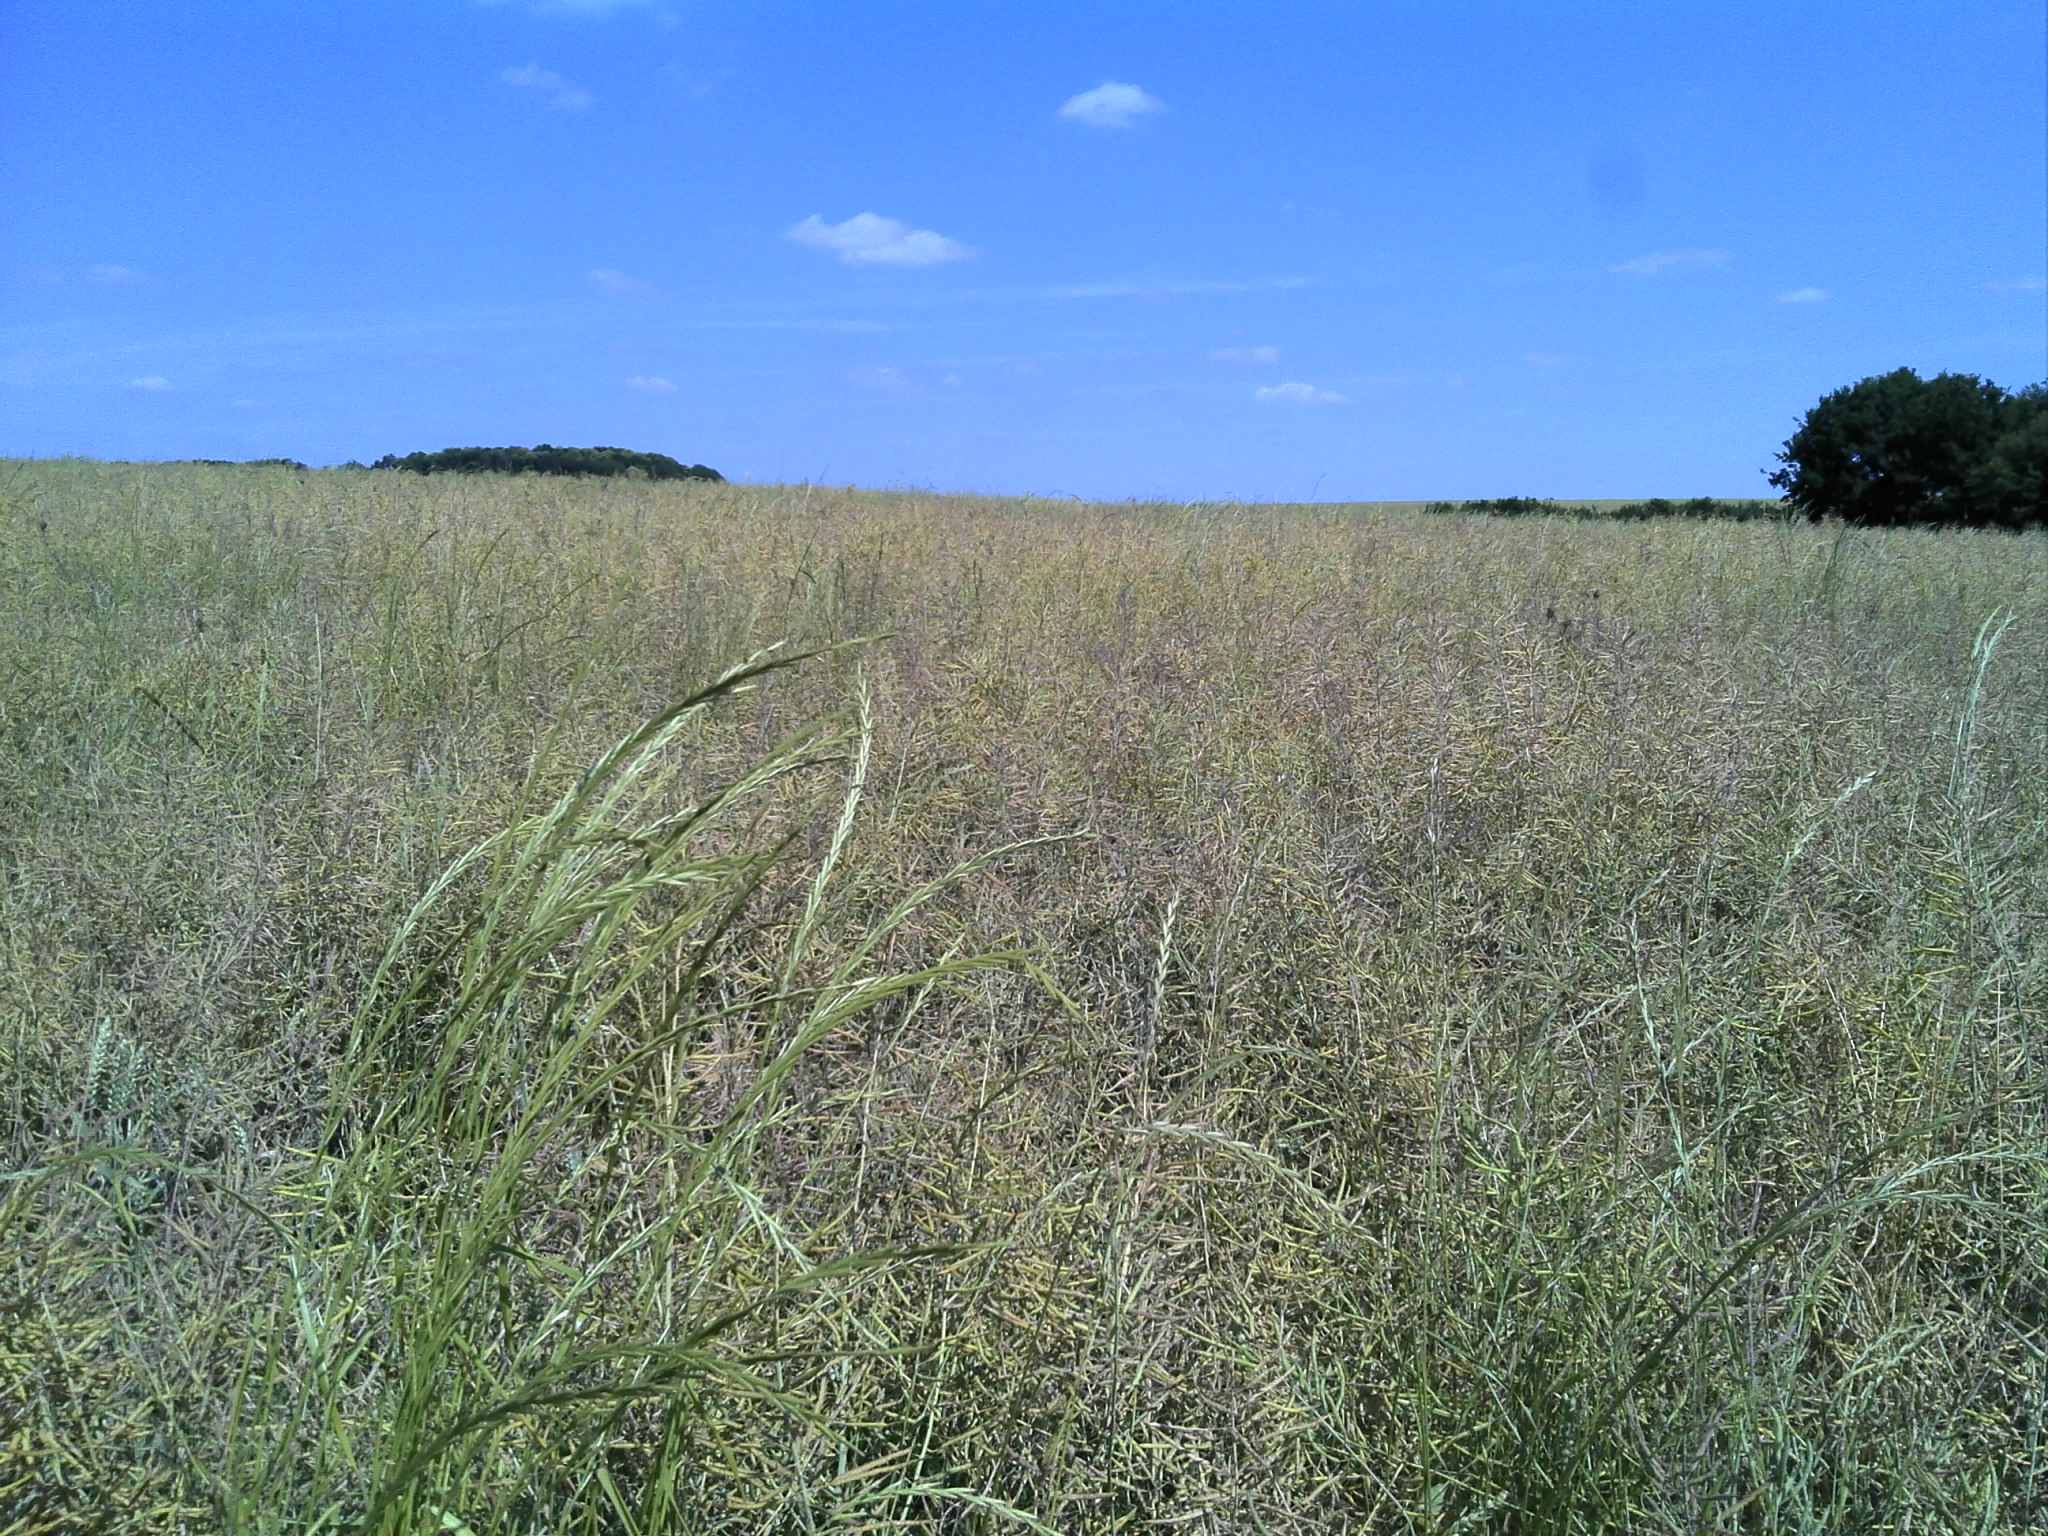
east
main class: Cropland
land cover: Rape and turnip rape
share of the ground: > 75 %
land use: Agriculture (excluding fallow land and kitchen gardens)
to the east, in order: Rape and turnip rape; Grass margins; Tracks; Grass margins; Maize
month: June
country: FR
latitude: 47.1493
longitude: 1.4545
